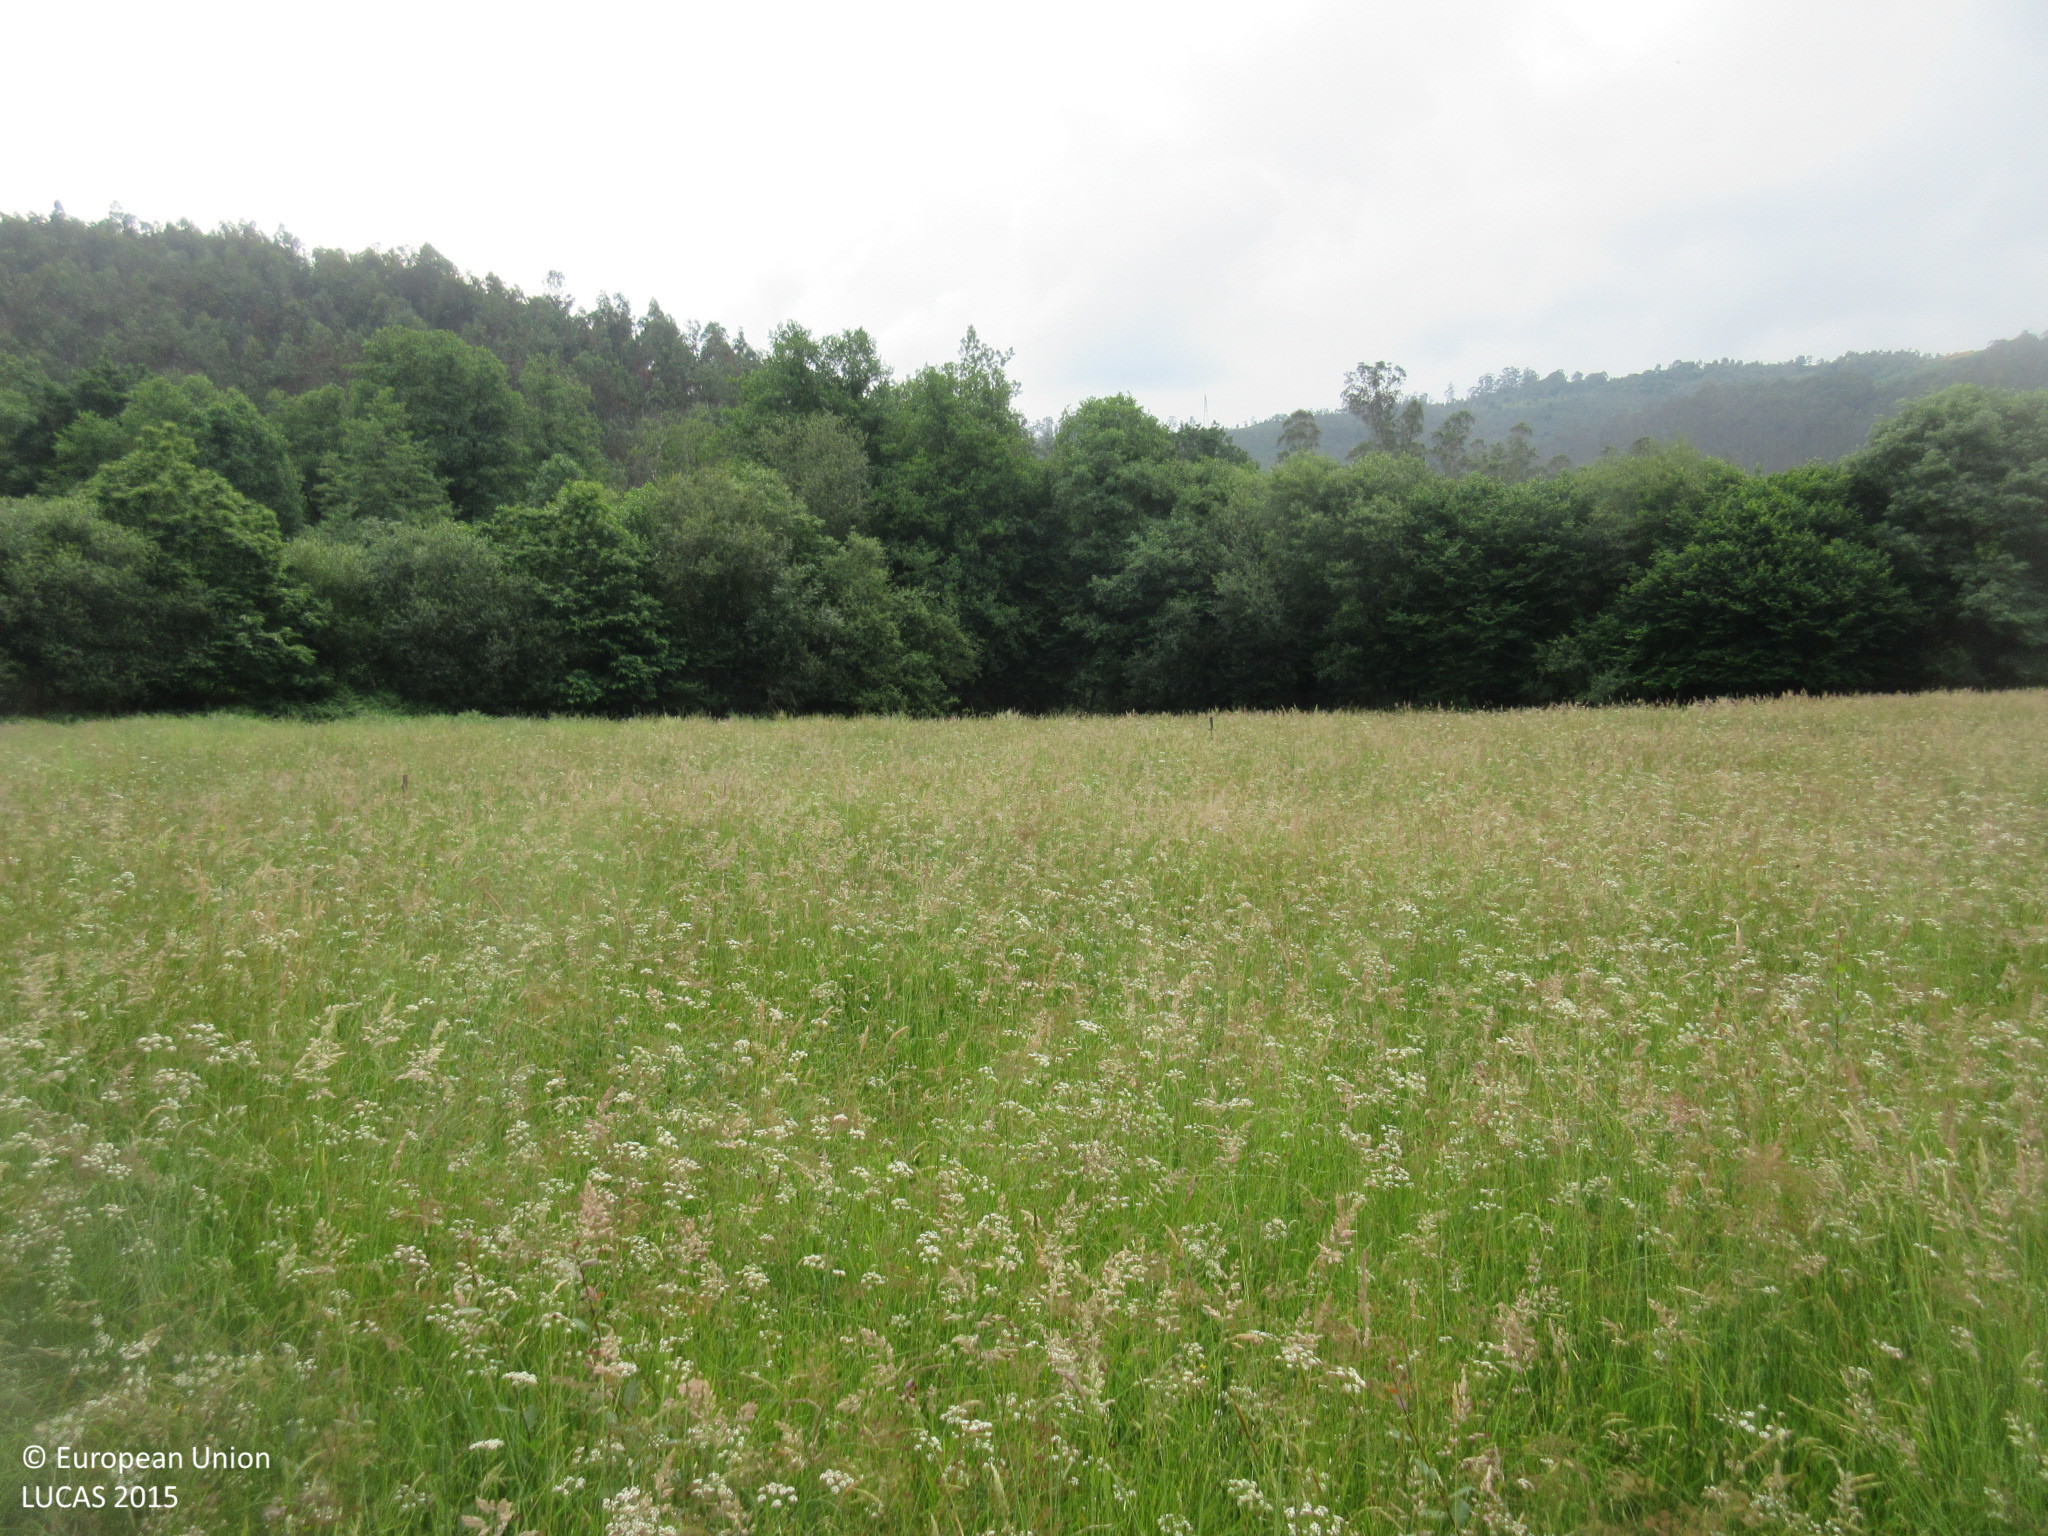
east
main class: Grassland
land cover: Grassland without tree/shrub cover
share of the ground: > 75 %
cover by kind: herbaceous plants 100 %
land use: Agriculture (excluding fallow land and kitchen gardens)
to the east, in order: Grassland without tree/shrub cover; Broadleaved woodland; Tracks; Broadleaved woodland; Tracks; Broadleaved woodland
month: June
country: ES
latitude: 43.4038
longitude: -5.9324
